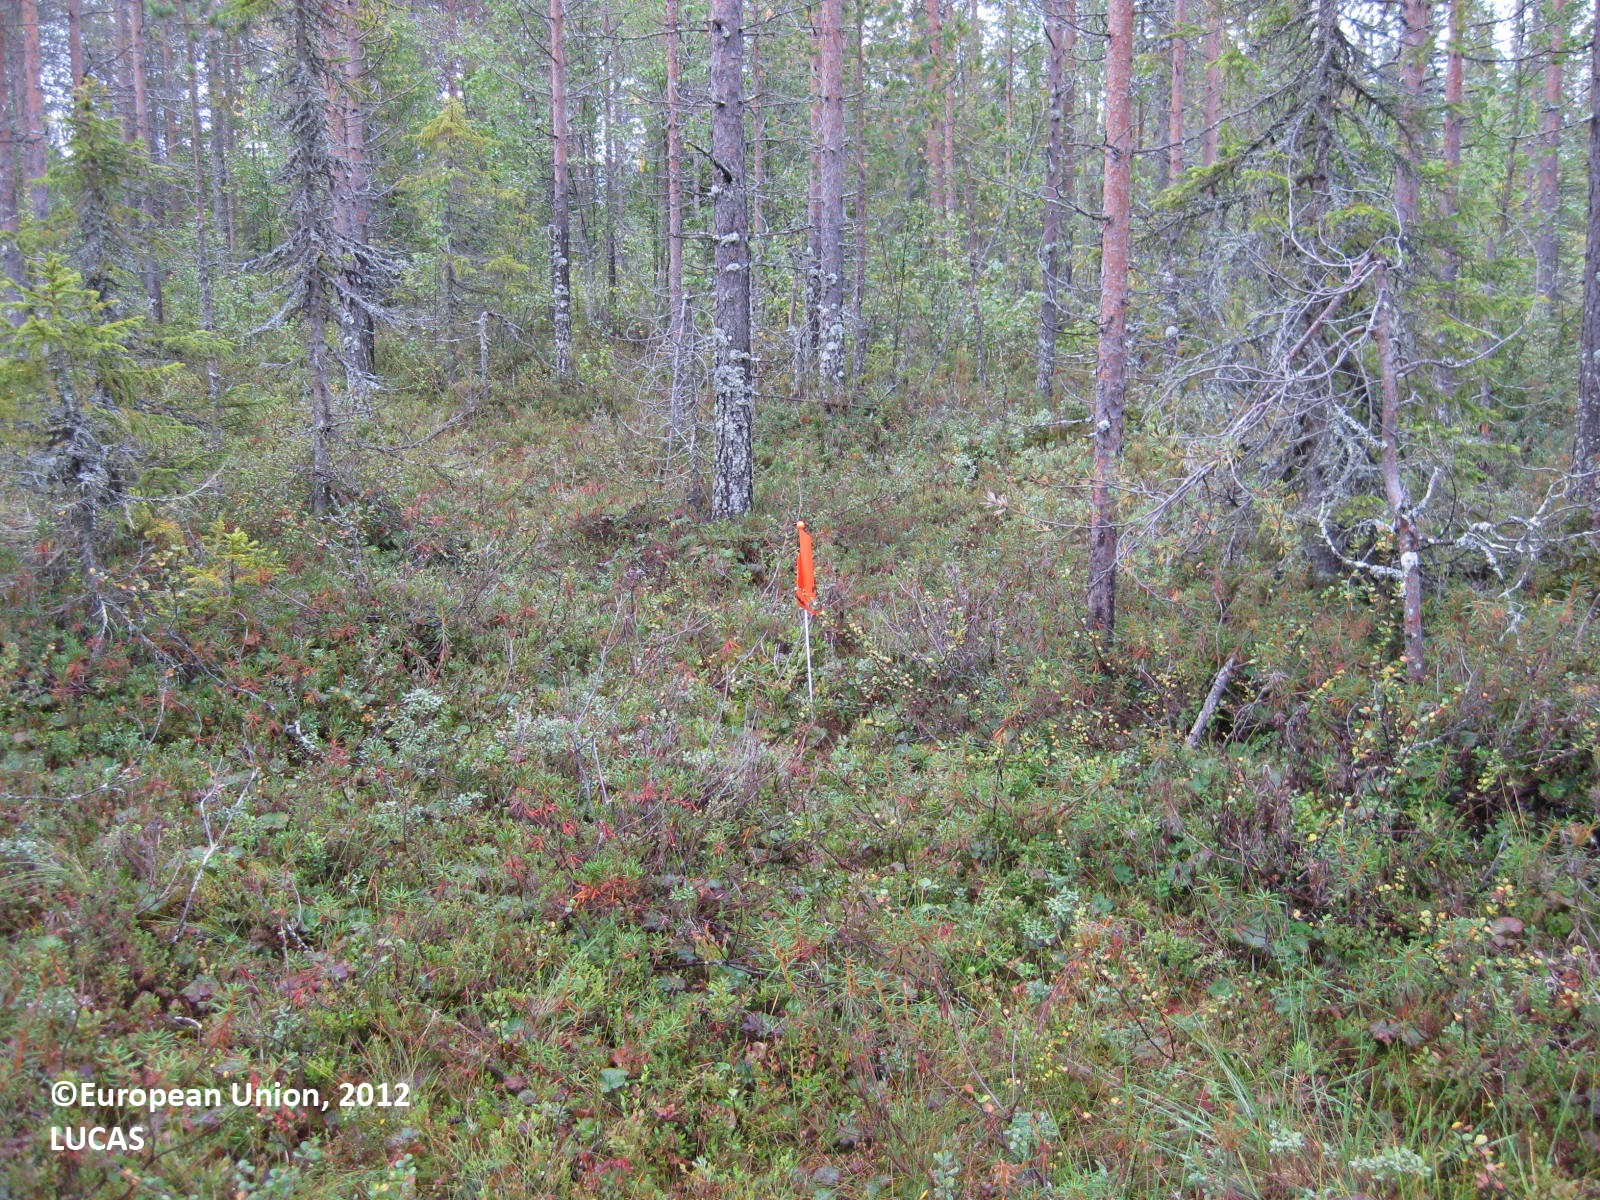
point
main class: Woodland
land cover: Pine dominated coniferous woodland
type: boreal forest
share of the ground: 50 - 75 %
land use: Forestry
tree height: > 5 m
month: August
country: FI
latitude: 66.1013
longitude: 28.8111
